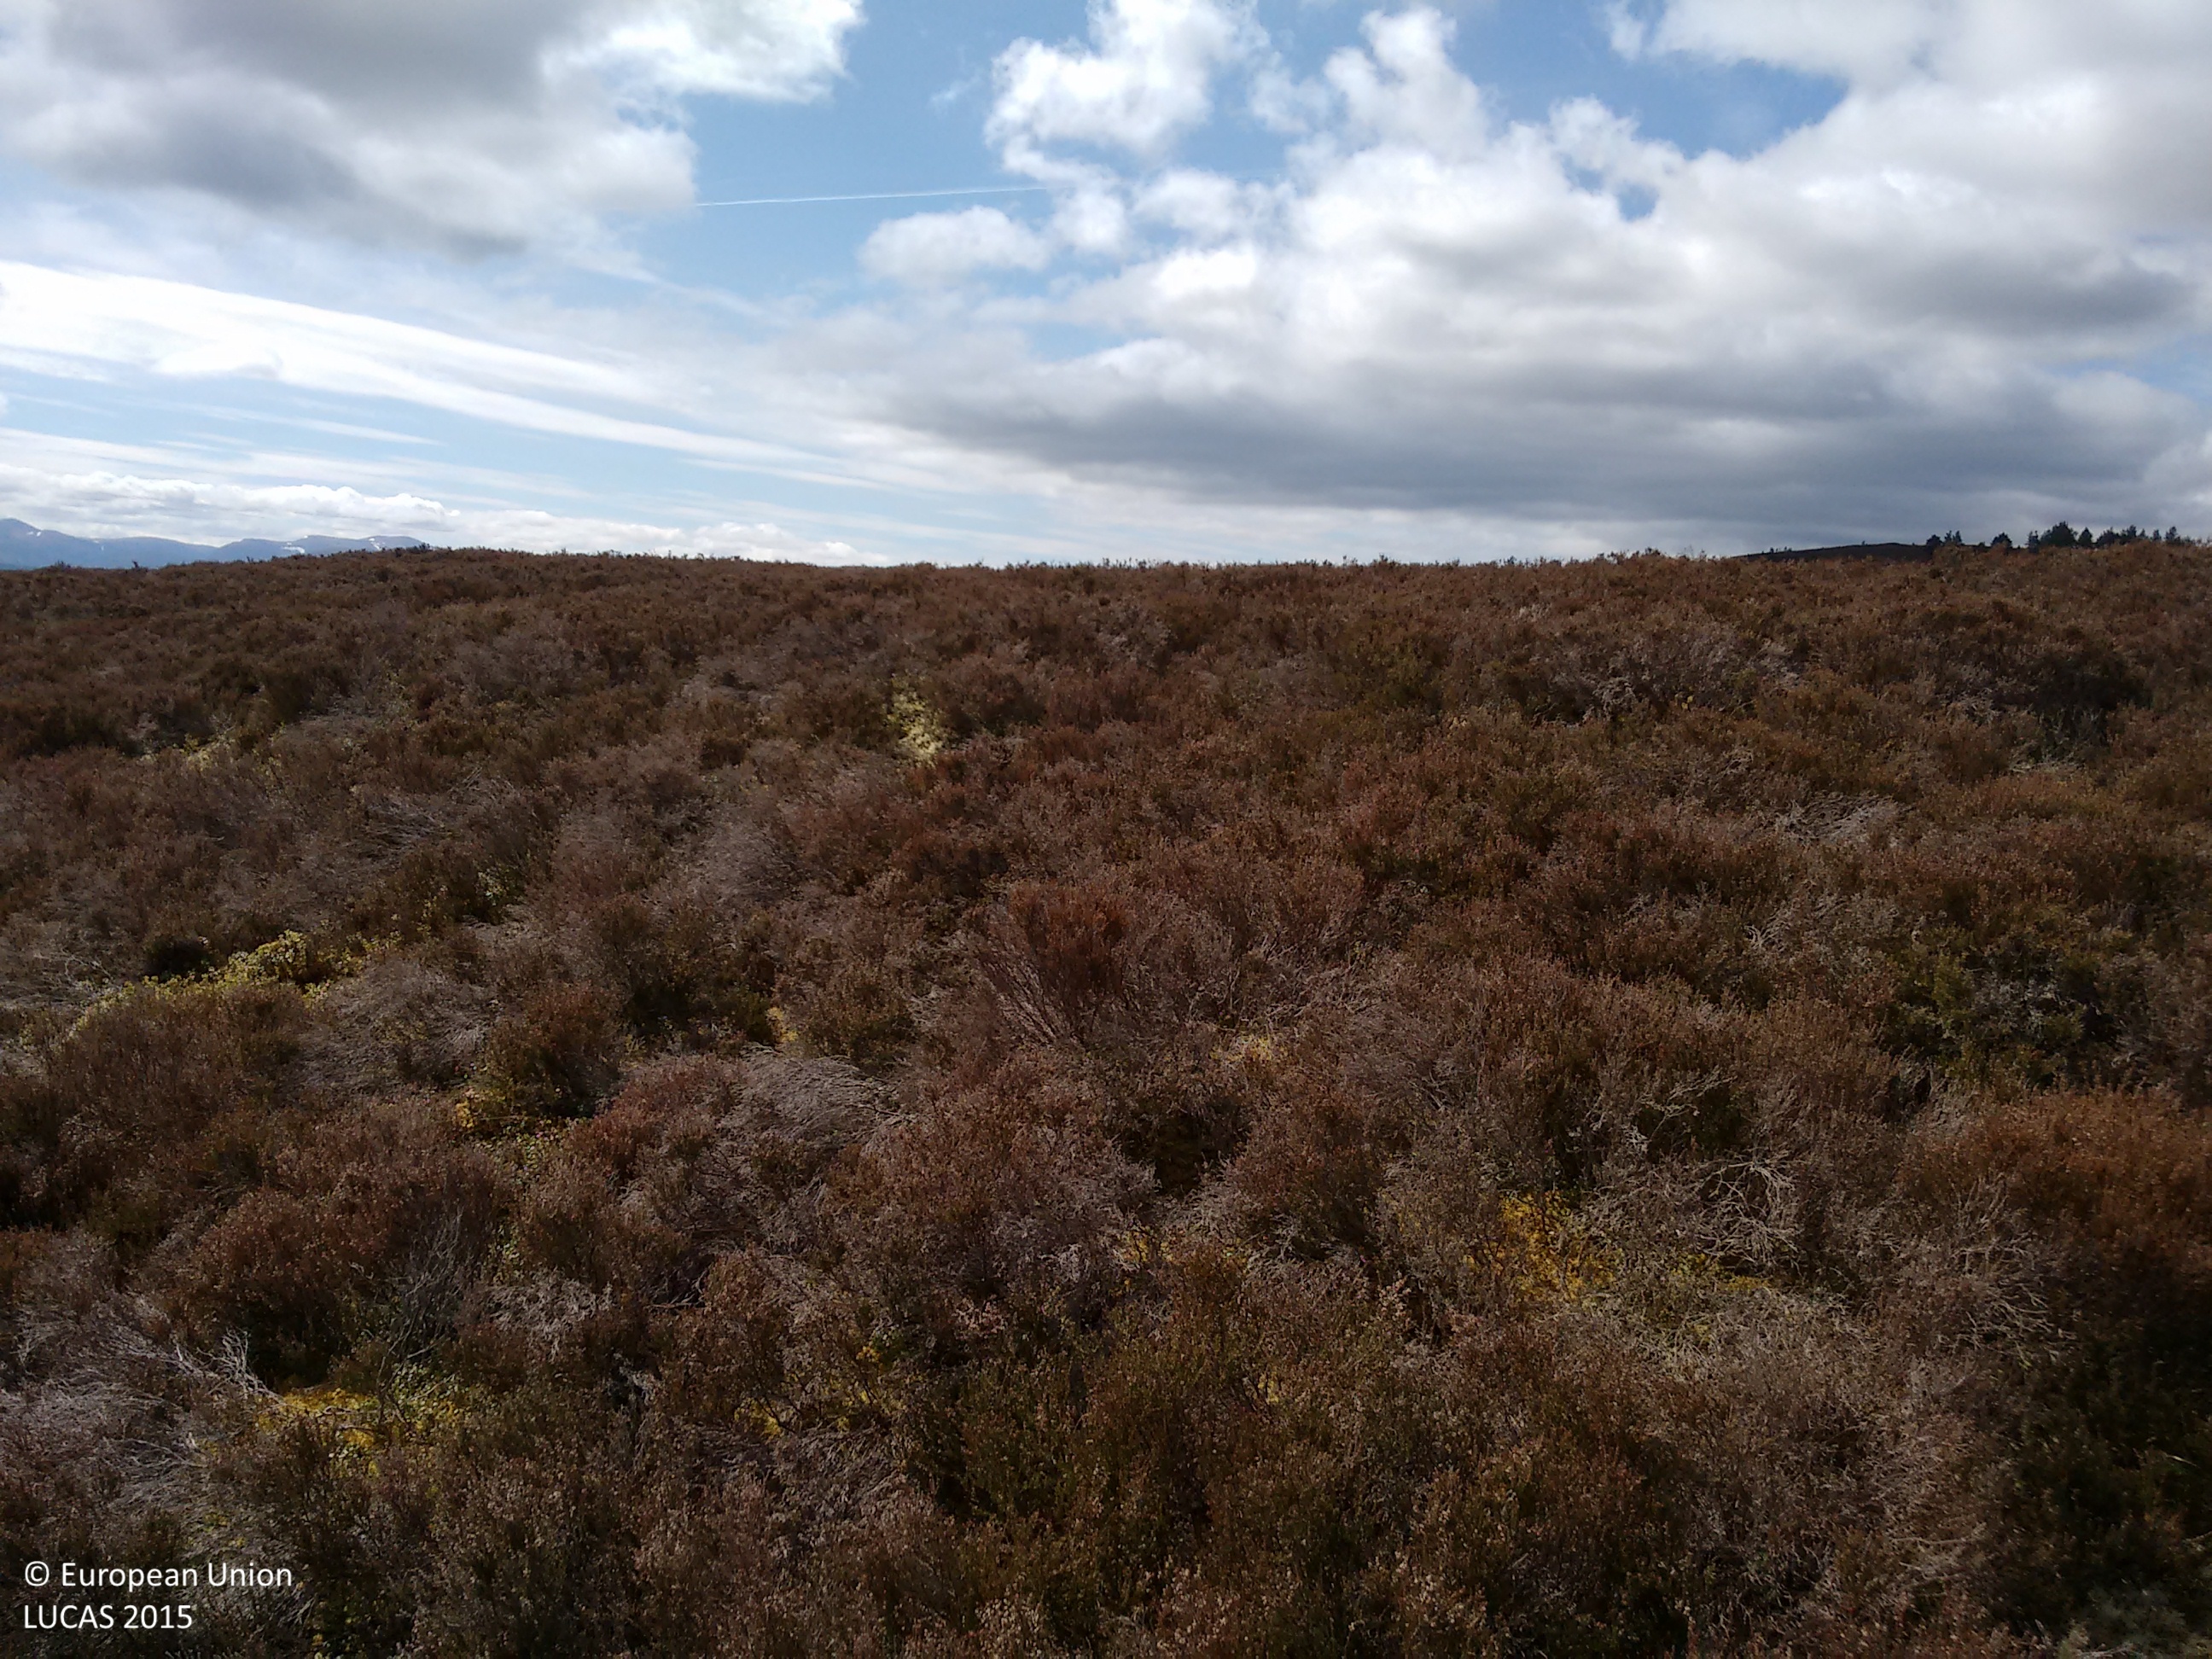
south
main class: Shrubland
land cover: Shrubland without tree cover
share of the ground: > 75 %
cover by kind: shrubs 85 %, herbaceous plants 10 %, lichens and mosses 5 %
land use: Agriculture (excluding fallow land and kitchen gardens)
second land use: Other primary production
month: June
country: GB
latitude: 57.3258
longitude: -3.7445
